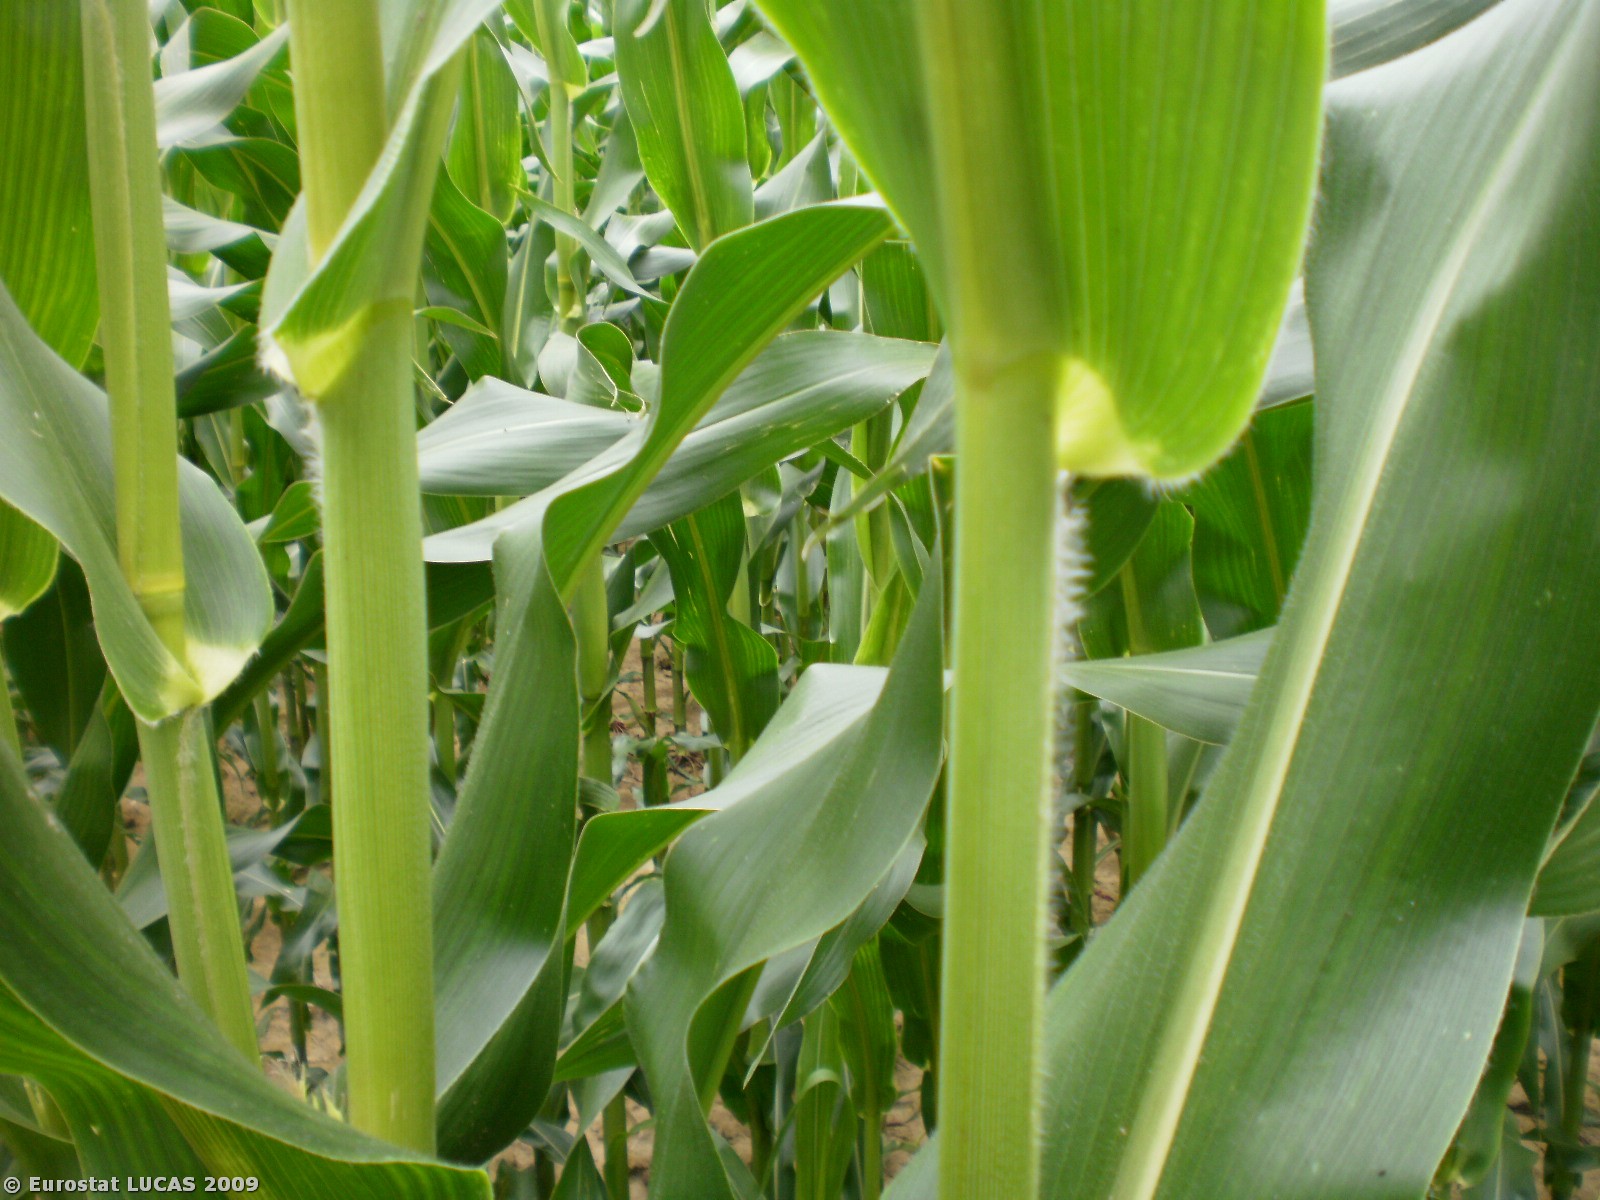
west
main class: Cropland
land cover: Maize
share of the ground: > 75 %
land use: Agriculture (excluding fallow land and kitchen gardens)
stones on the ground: < 10 %
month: July
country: BE
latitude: 50.8225
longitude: 2.7917
